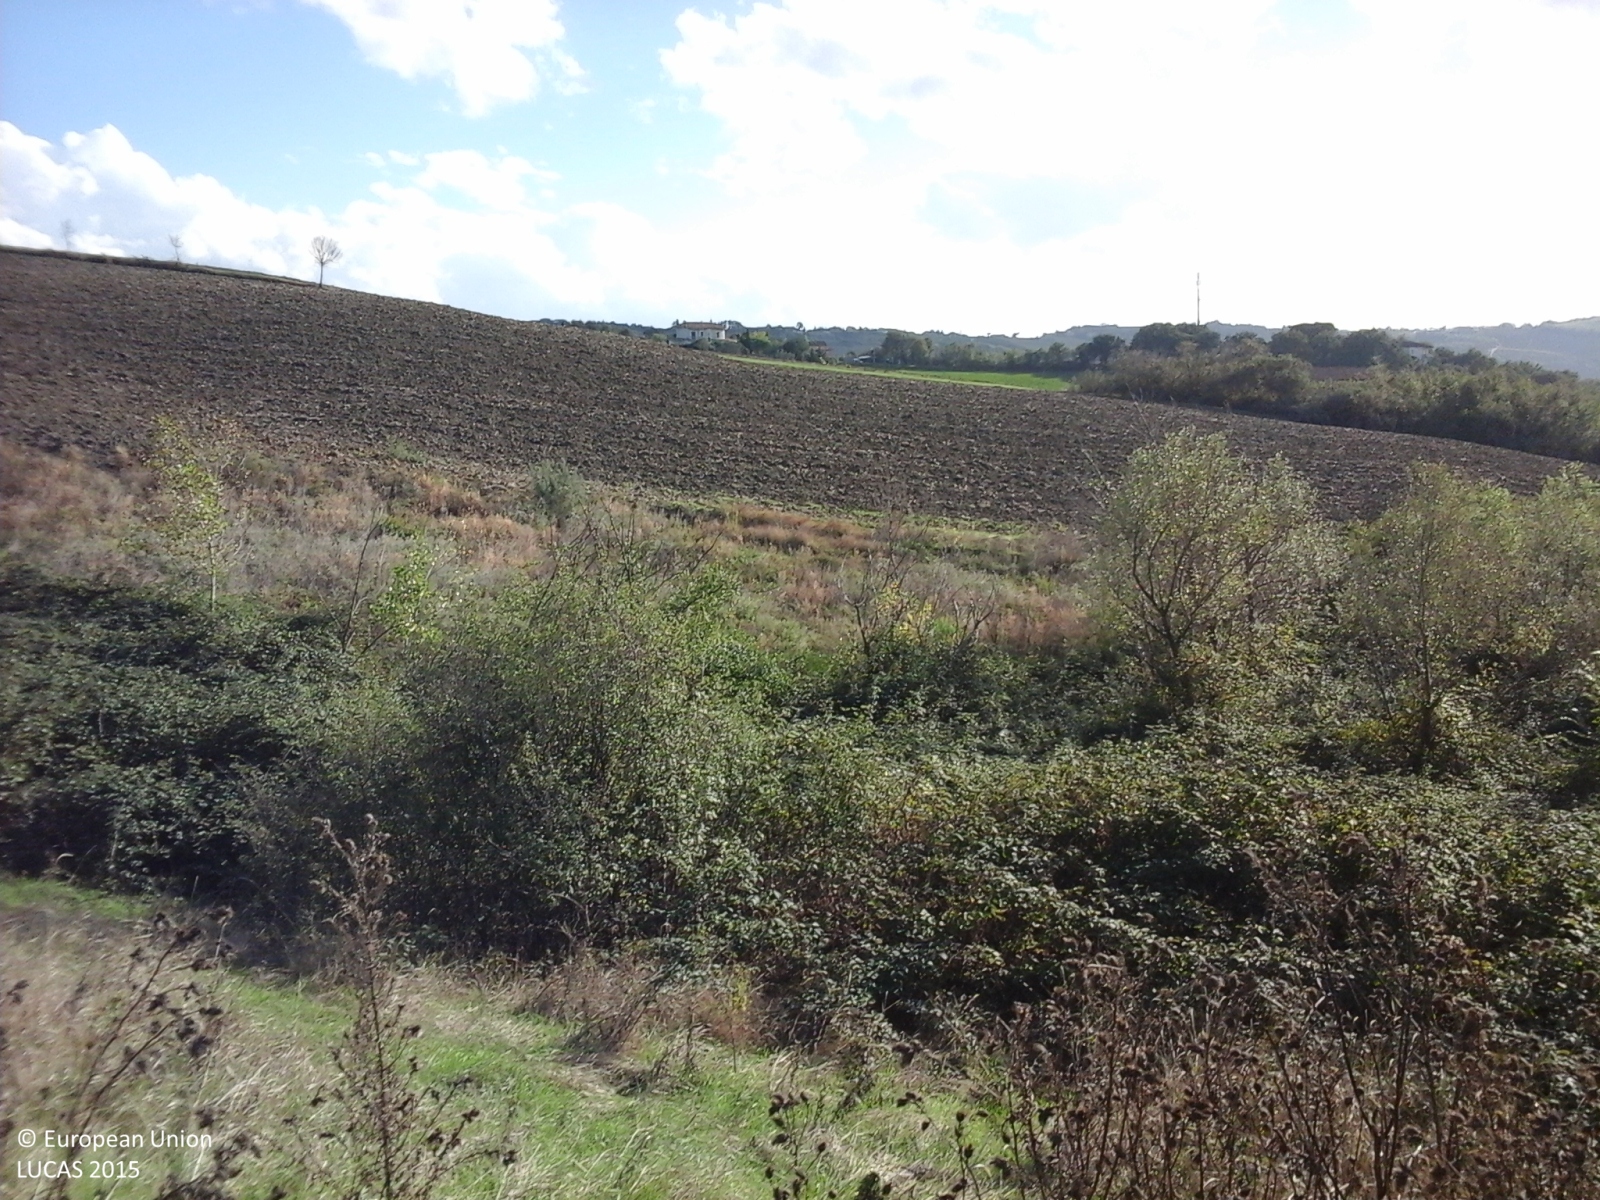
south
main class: Cropland
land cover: Durum wheat
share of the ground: < 10 %
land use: Agriculture (excluding fallow land and kitchen gardens)
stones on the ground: < 10 %
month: October
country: IT
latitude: 43.5367
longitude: 13.3949
